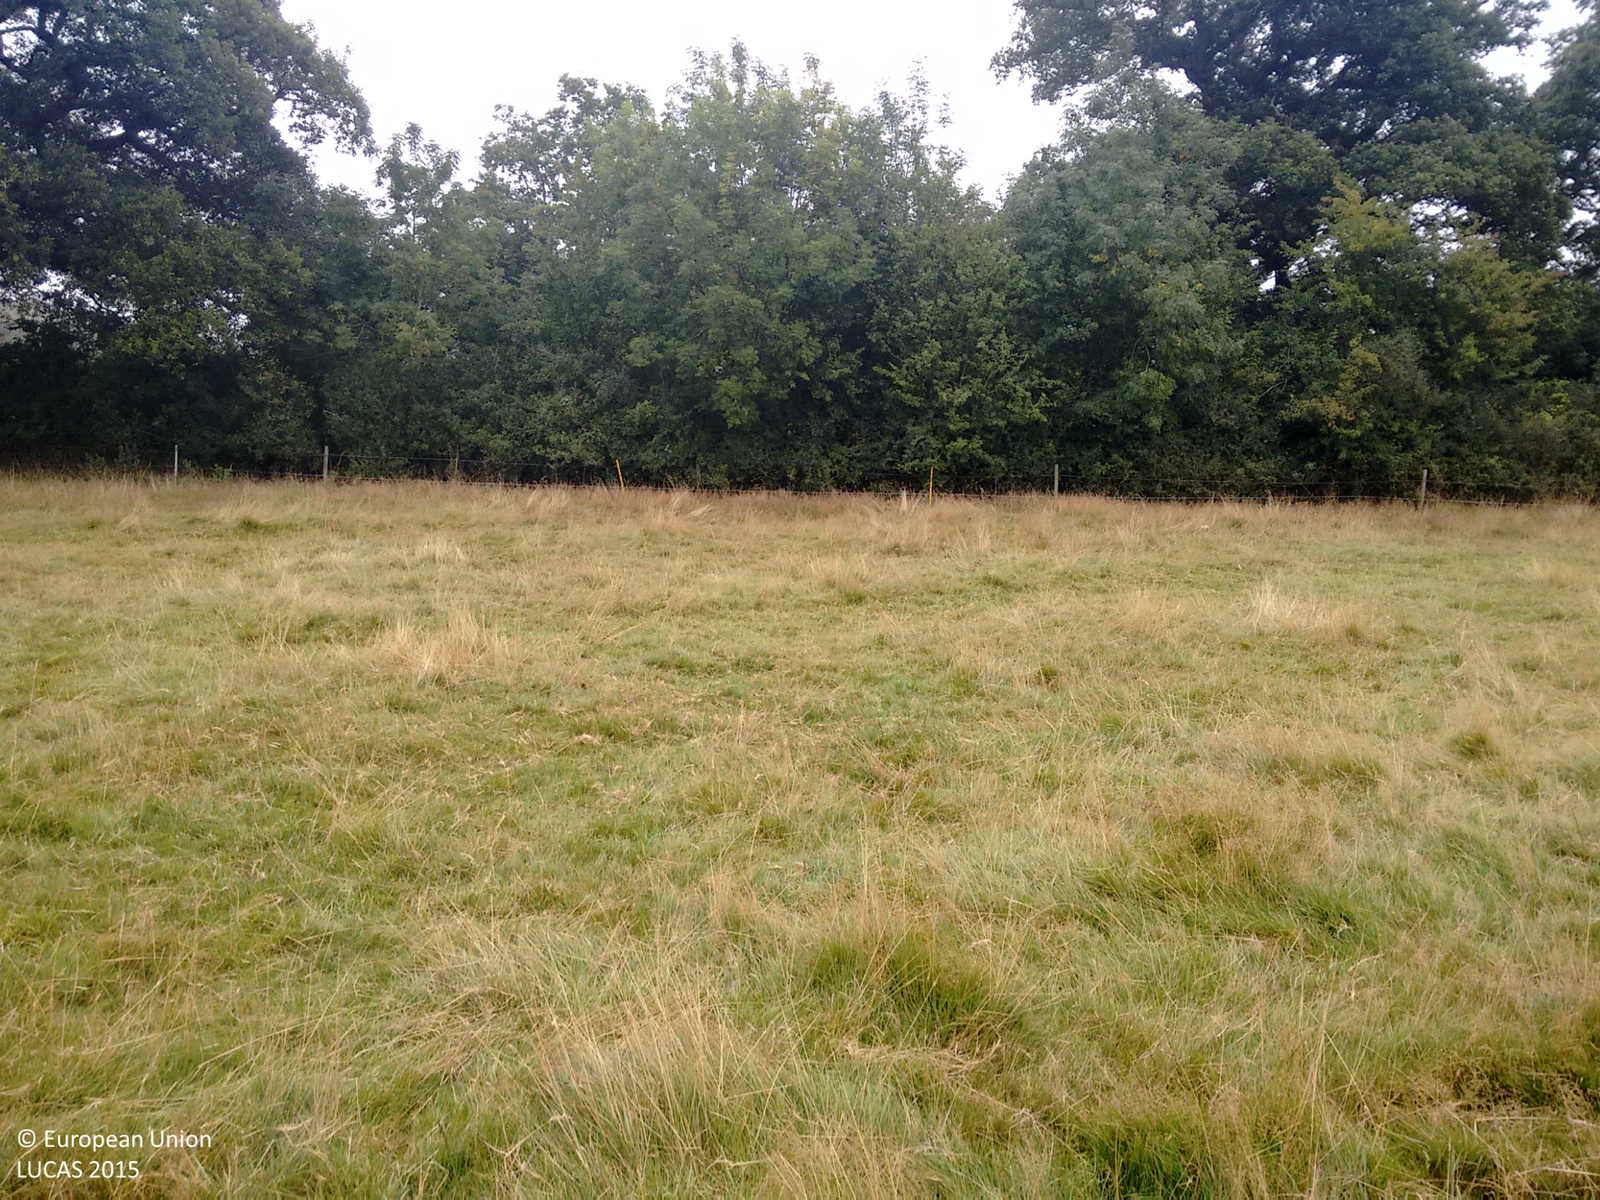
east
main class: Grassland
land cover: Grassland without tree/shrub cover
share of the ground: > 75 %
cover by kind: herbaceous plants 100 %
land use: Agriculture (excluding fallow land and kitchen gardens)
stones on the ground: < 10 %
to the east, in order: Grassland without tree/shrub cover; Fences; Abandoned hedges; Paved roads, cycling and walking lanes; Abandoned hedges; Grassland without tree/shrub cover; Abandoned hedges; Maize
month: September
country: GB
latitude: 52.6257
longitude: -2.8208
